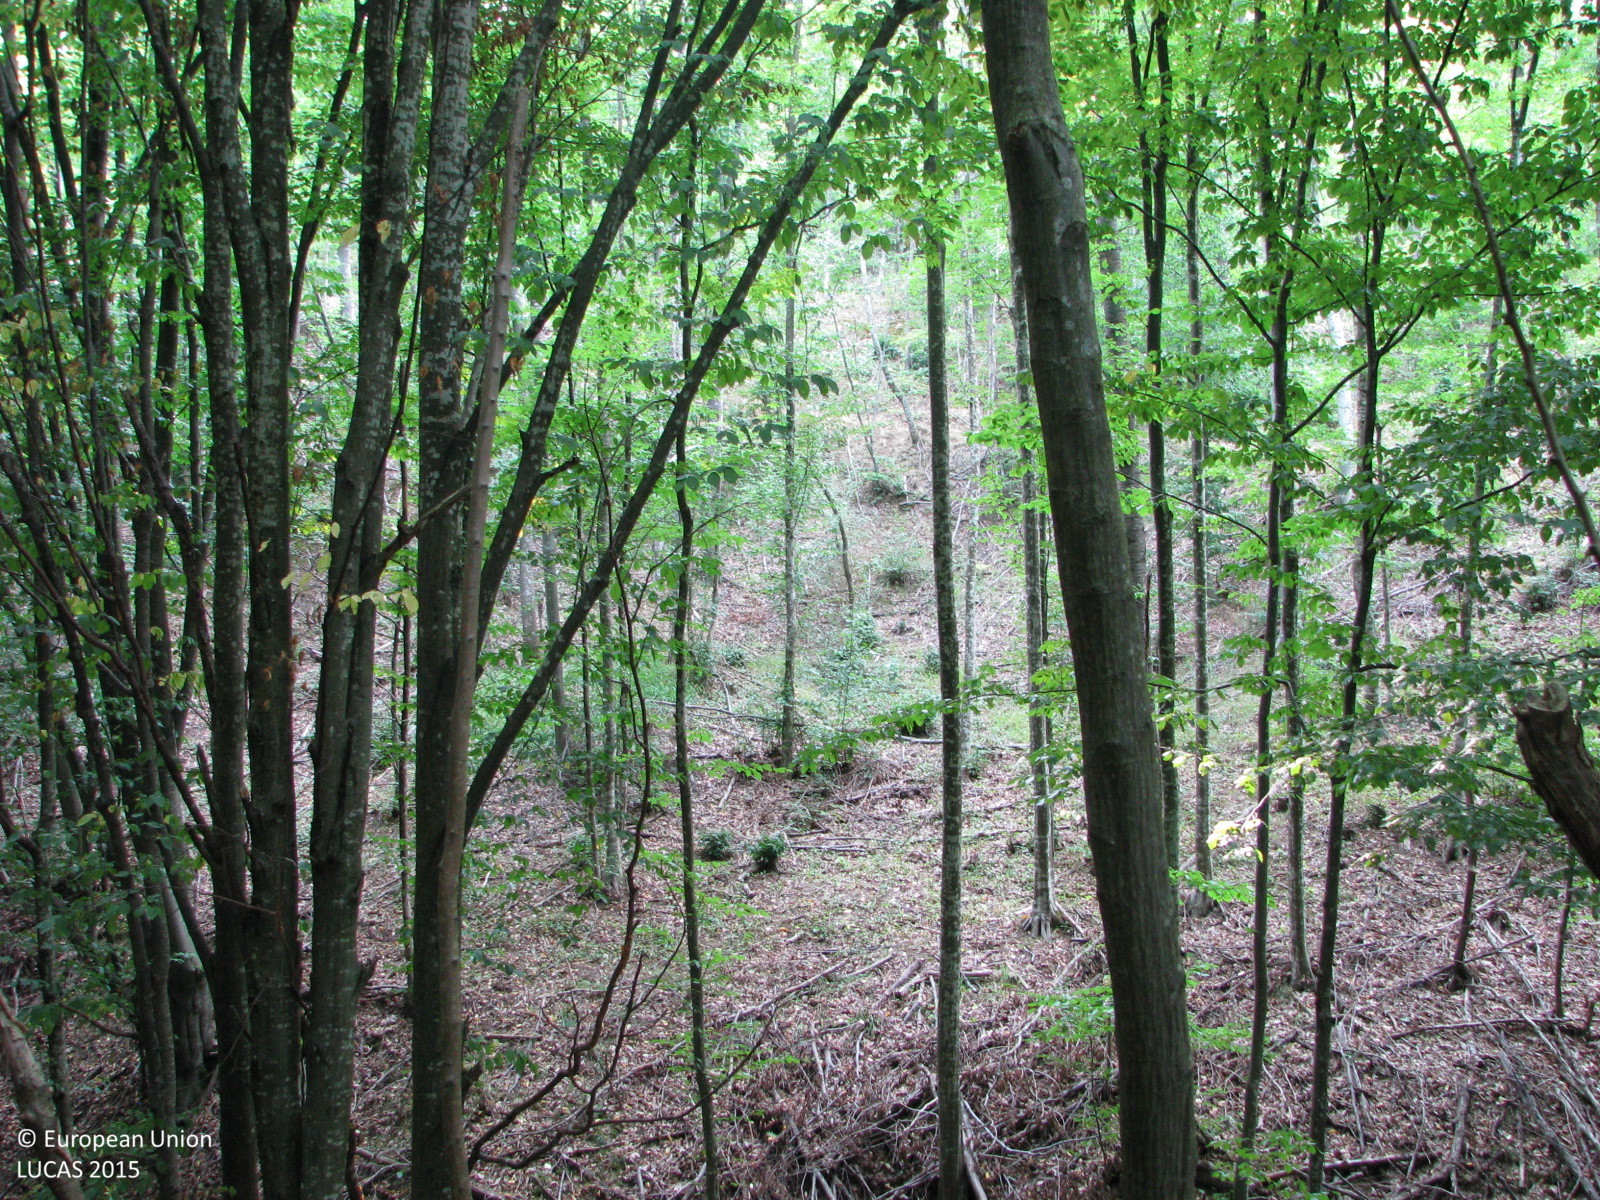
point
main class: Woodland
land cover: Broadleaved woodland
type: beech forest
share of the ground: 50 - 75 %
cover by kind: broadleaved forest trees 60 %, consolidated bare surface 25 %, shrubs 10 %, herbaceous plants 5 %
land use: Forestry
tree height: > 5 m
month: August
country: BG
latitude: 42.8791
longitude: 26.1138
